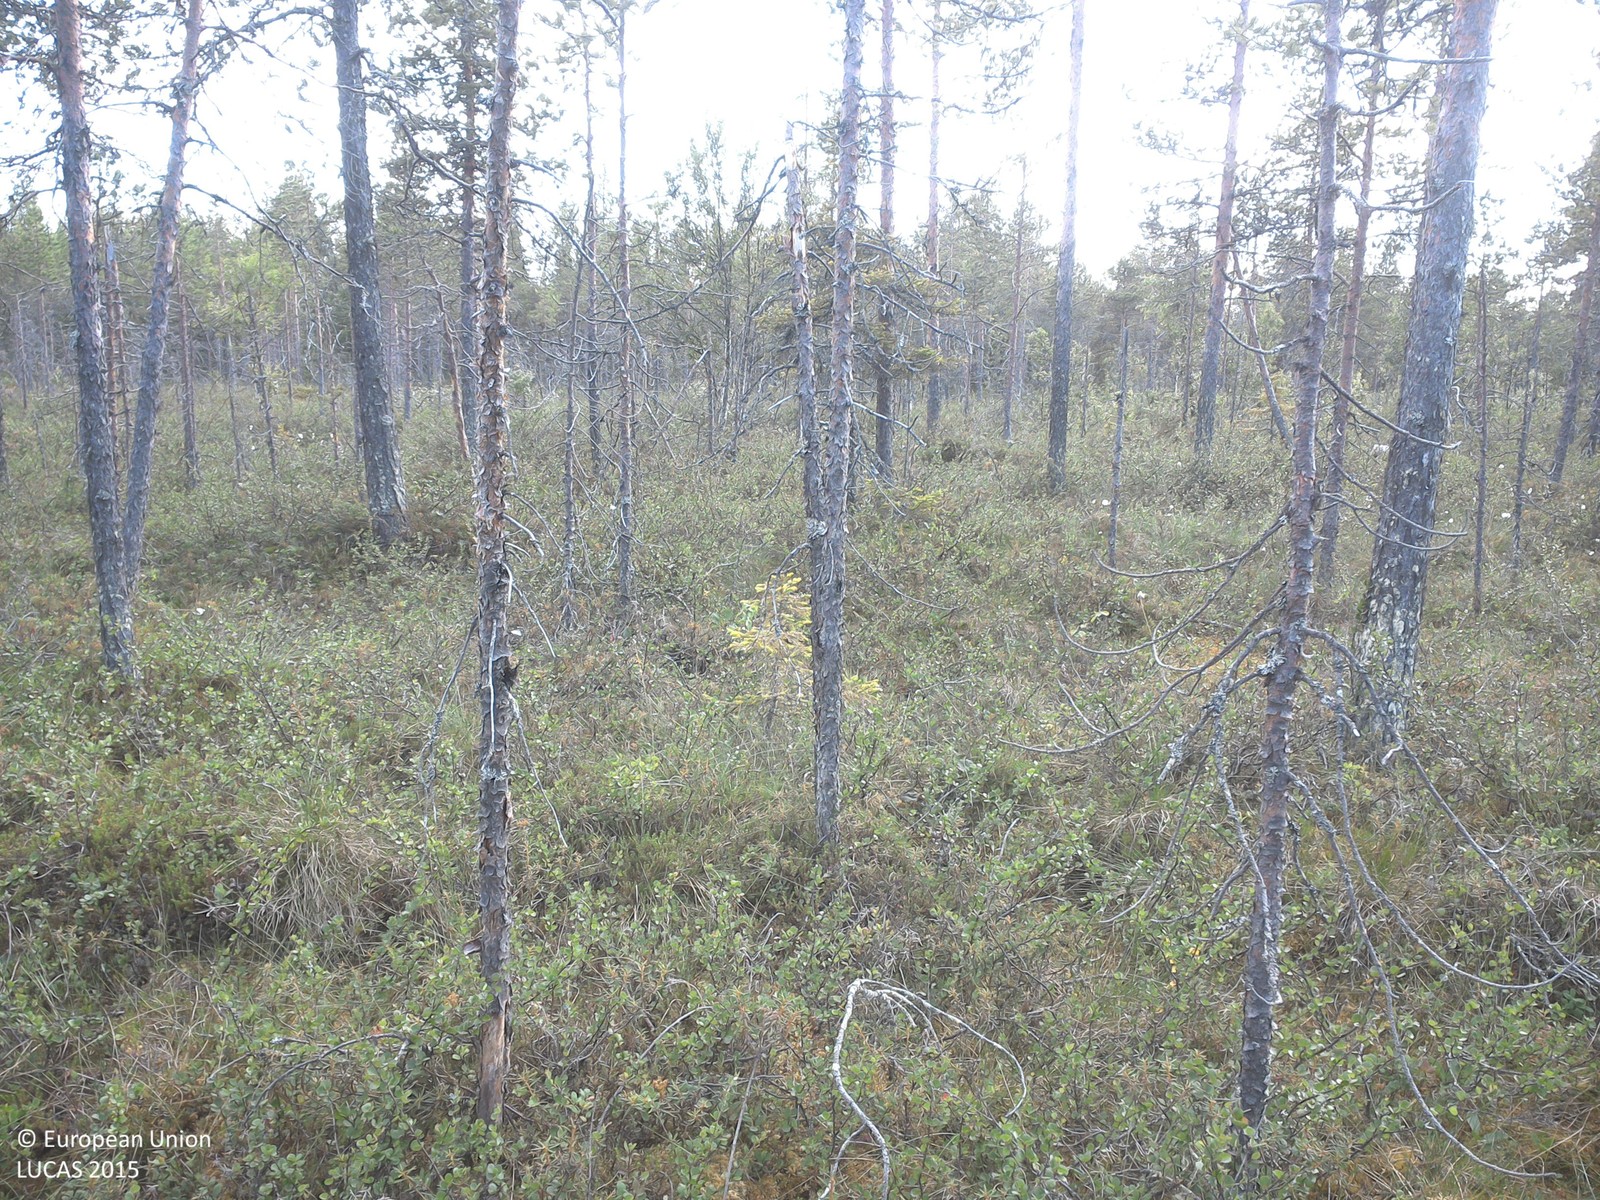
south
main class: Woodland
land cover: Pine dominated coniferous woodland
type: boreal forest
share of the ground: 10 - 25 %
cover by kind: shrubs 65 %, coniferous forest trees 15 %, lichens and mosses 15 %, herbaceous plants 5 %
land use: Forestry
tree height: < 5 m
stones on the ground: < 10 %
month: July
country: SE
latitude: 67.4476
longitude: 22.2225
